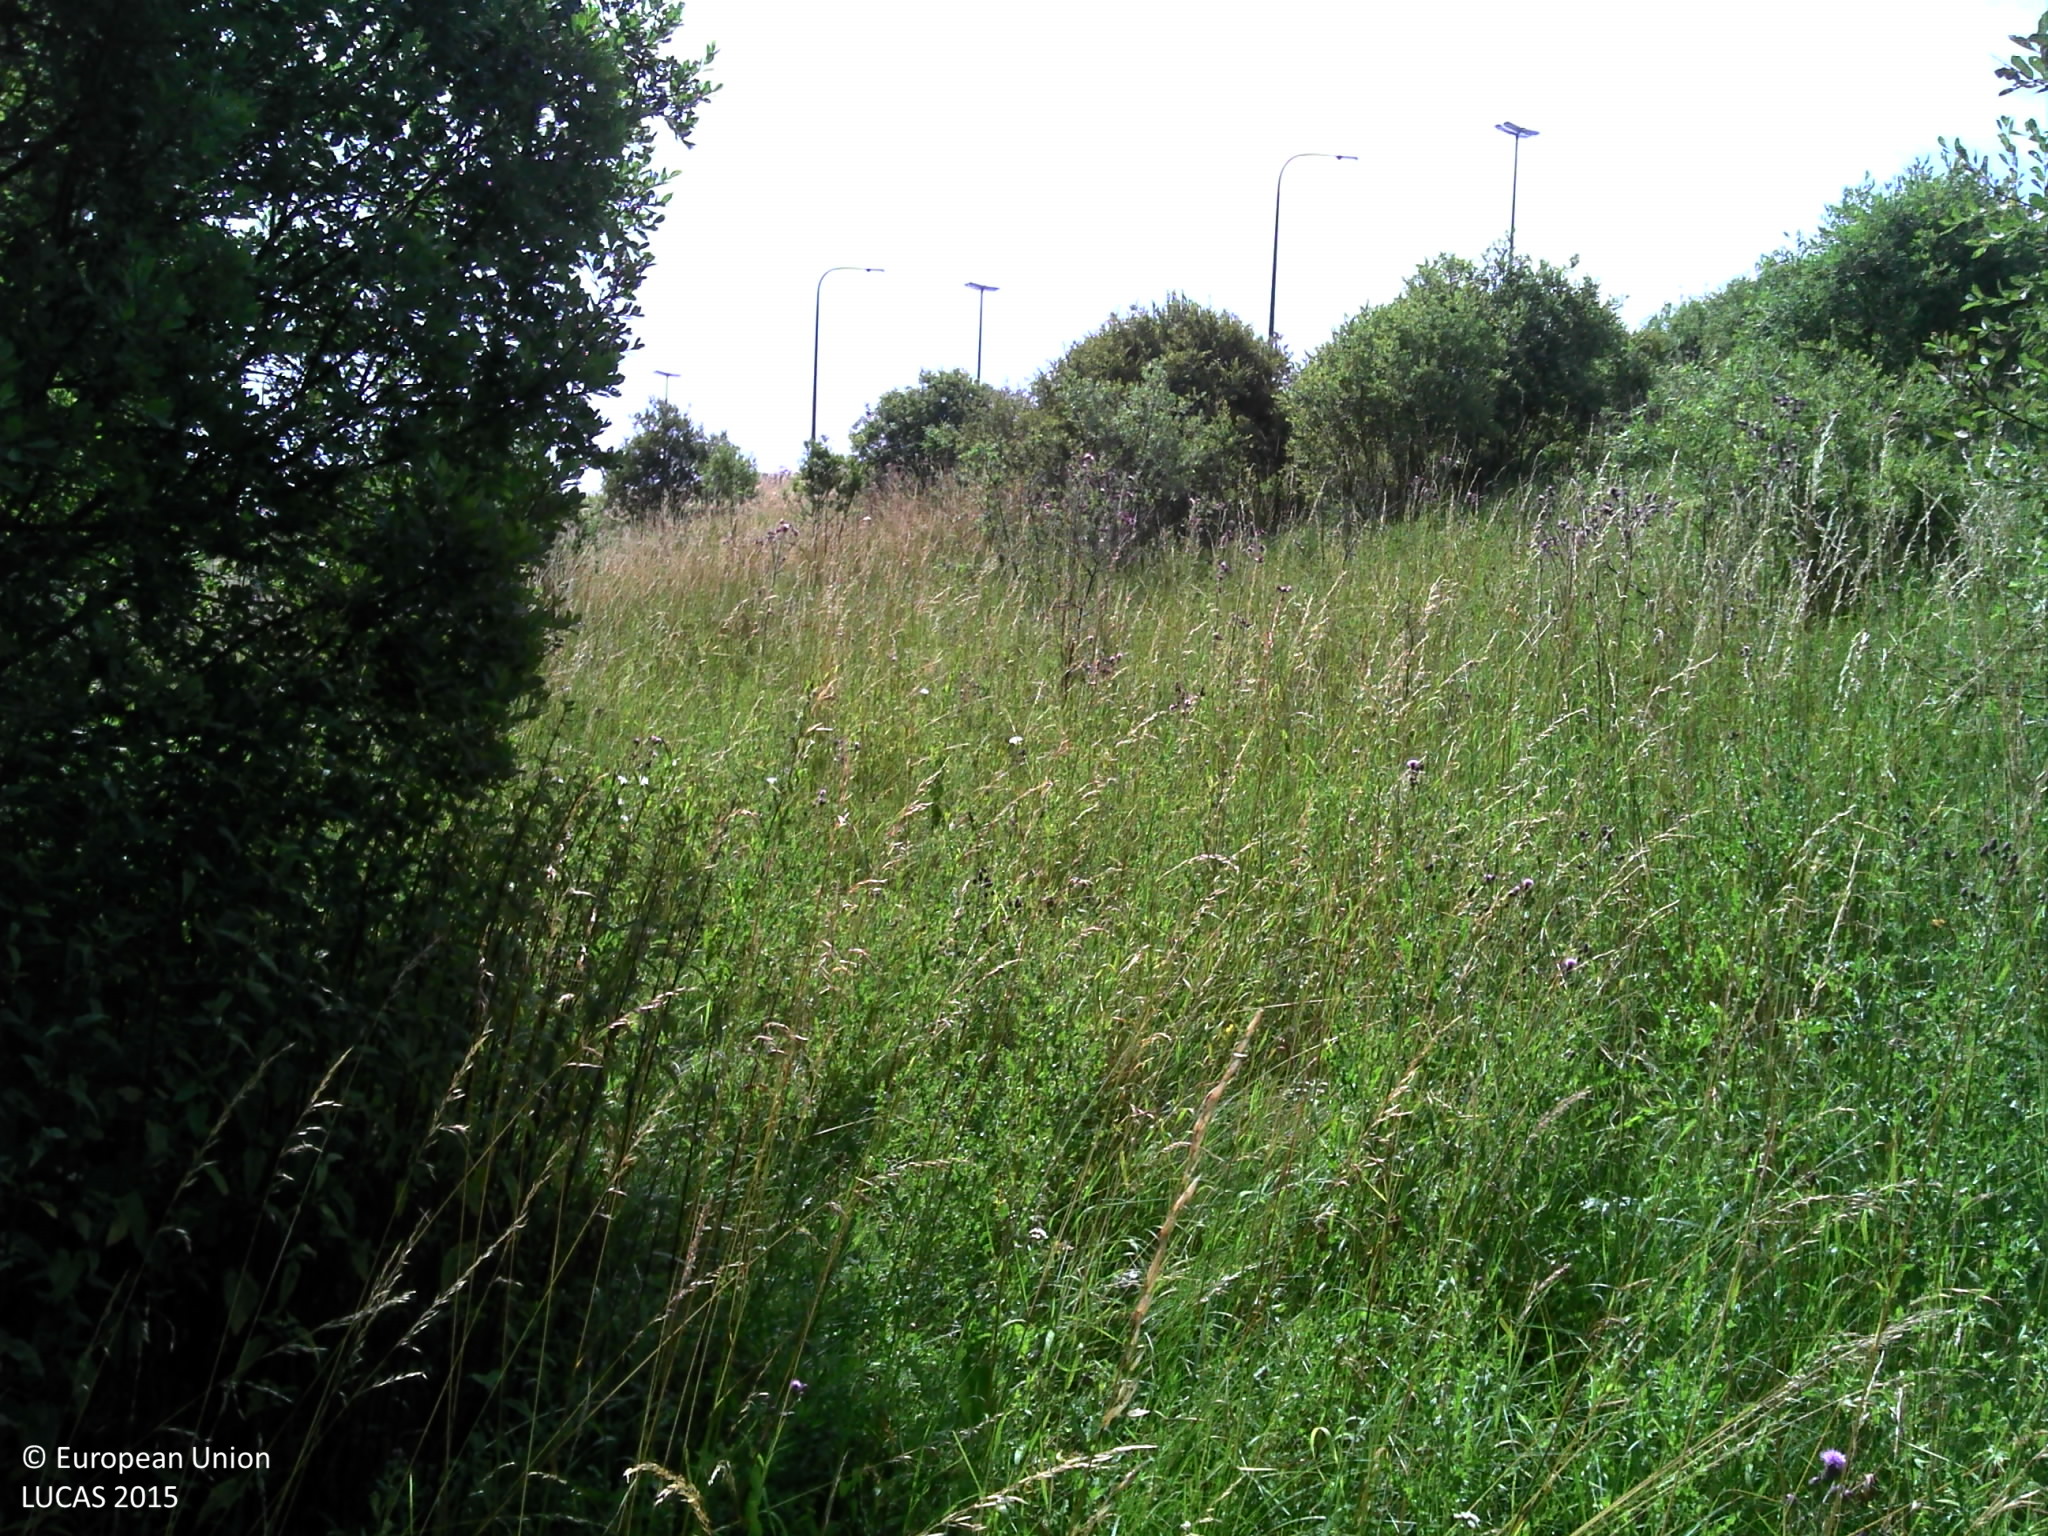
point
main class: Shrubland
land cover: Shrubland without tree cover
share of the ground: 50 - 75 %
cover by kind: shrubs 50 %, herbaceous plants 50 %
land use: Road transport
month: July
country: BE
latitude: 49.6737
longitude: 5.7724
